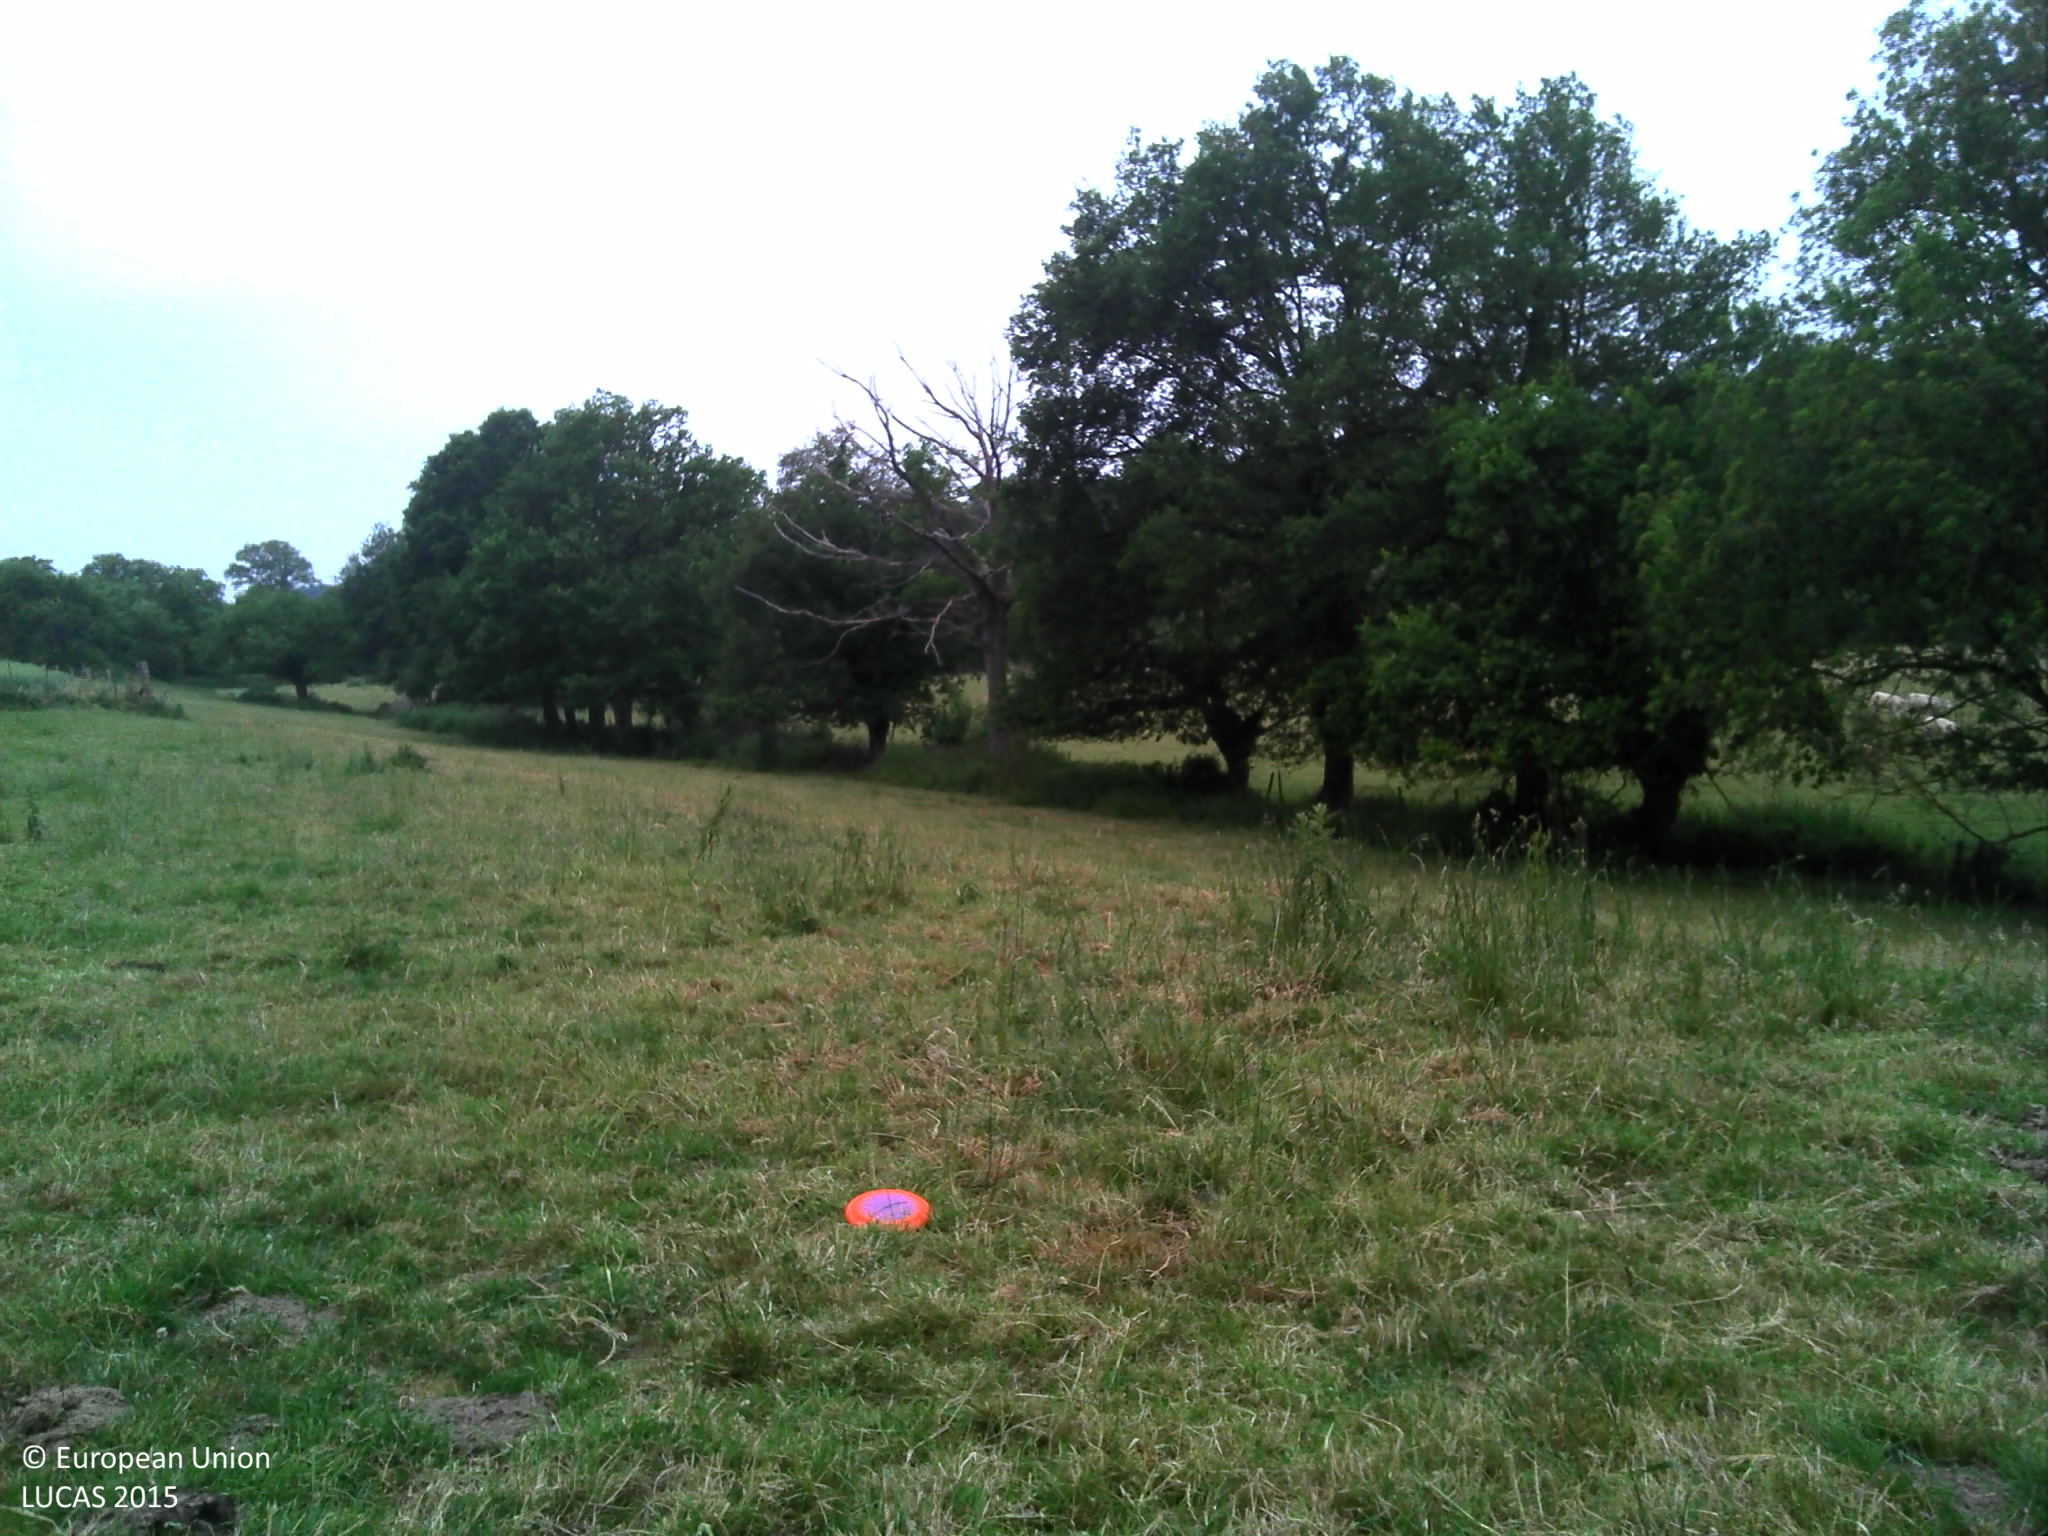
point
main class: Grassland
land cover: Grassland without tree/shrub cover
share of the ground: > 75 %
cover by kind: herbaceous plants 100 %
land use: Agriculture (excluding fallow land and kitchen gardens)
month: June
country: FR
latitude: 48.3073
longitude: -0.0471
